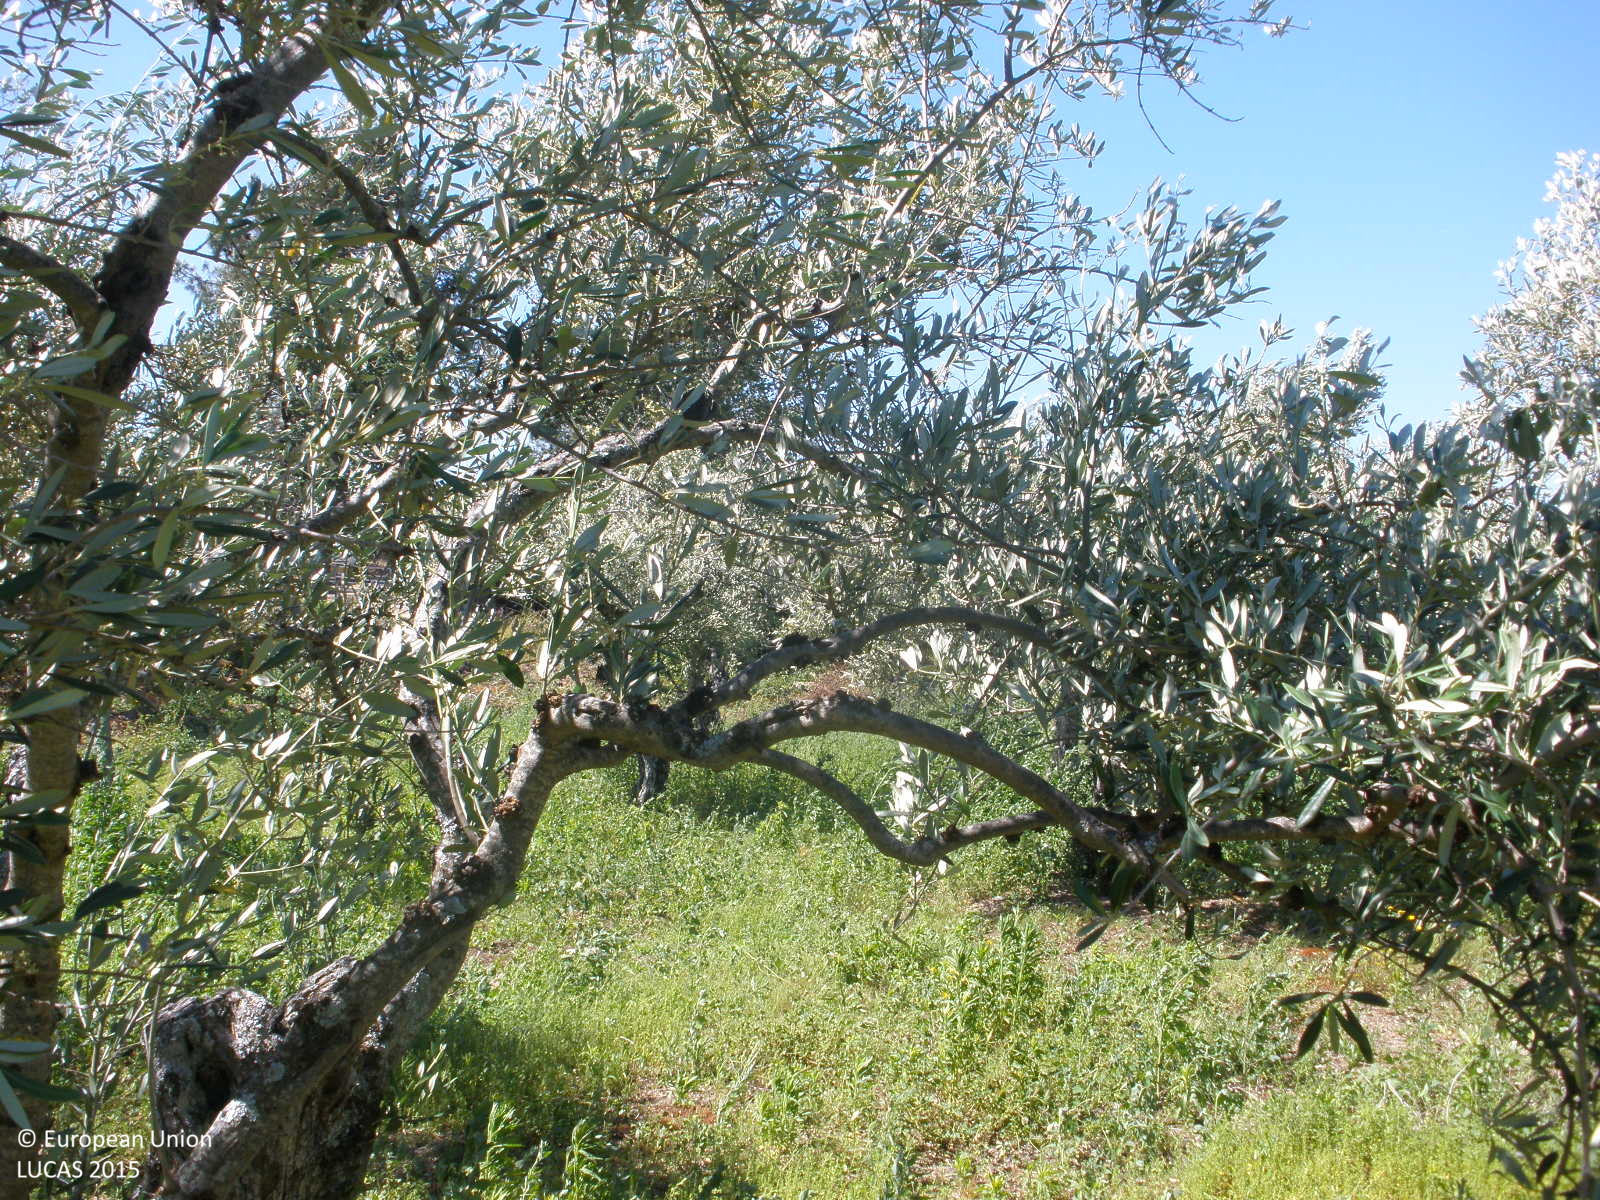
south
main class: Cropland
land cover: Olive groves
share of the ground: 50 - 75 %
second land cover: Spontaneously vegetated surfaces
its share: > 75 %
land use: Agriculture (excluding fallow land and kitchen gardens)
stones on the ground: < 10 %
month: May
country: ES
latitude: 40.2159
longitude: -6.8586
